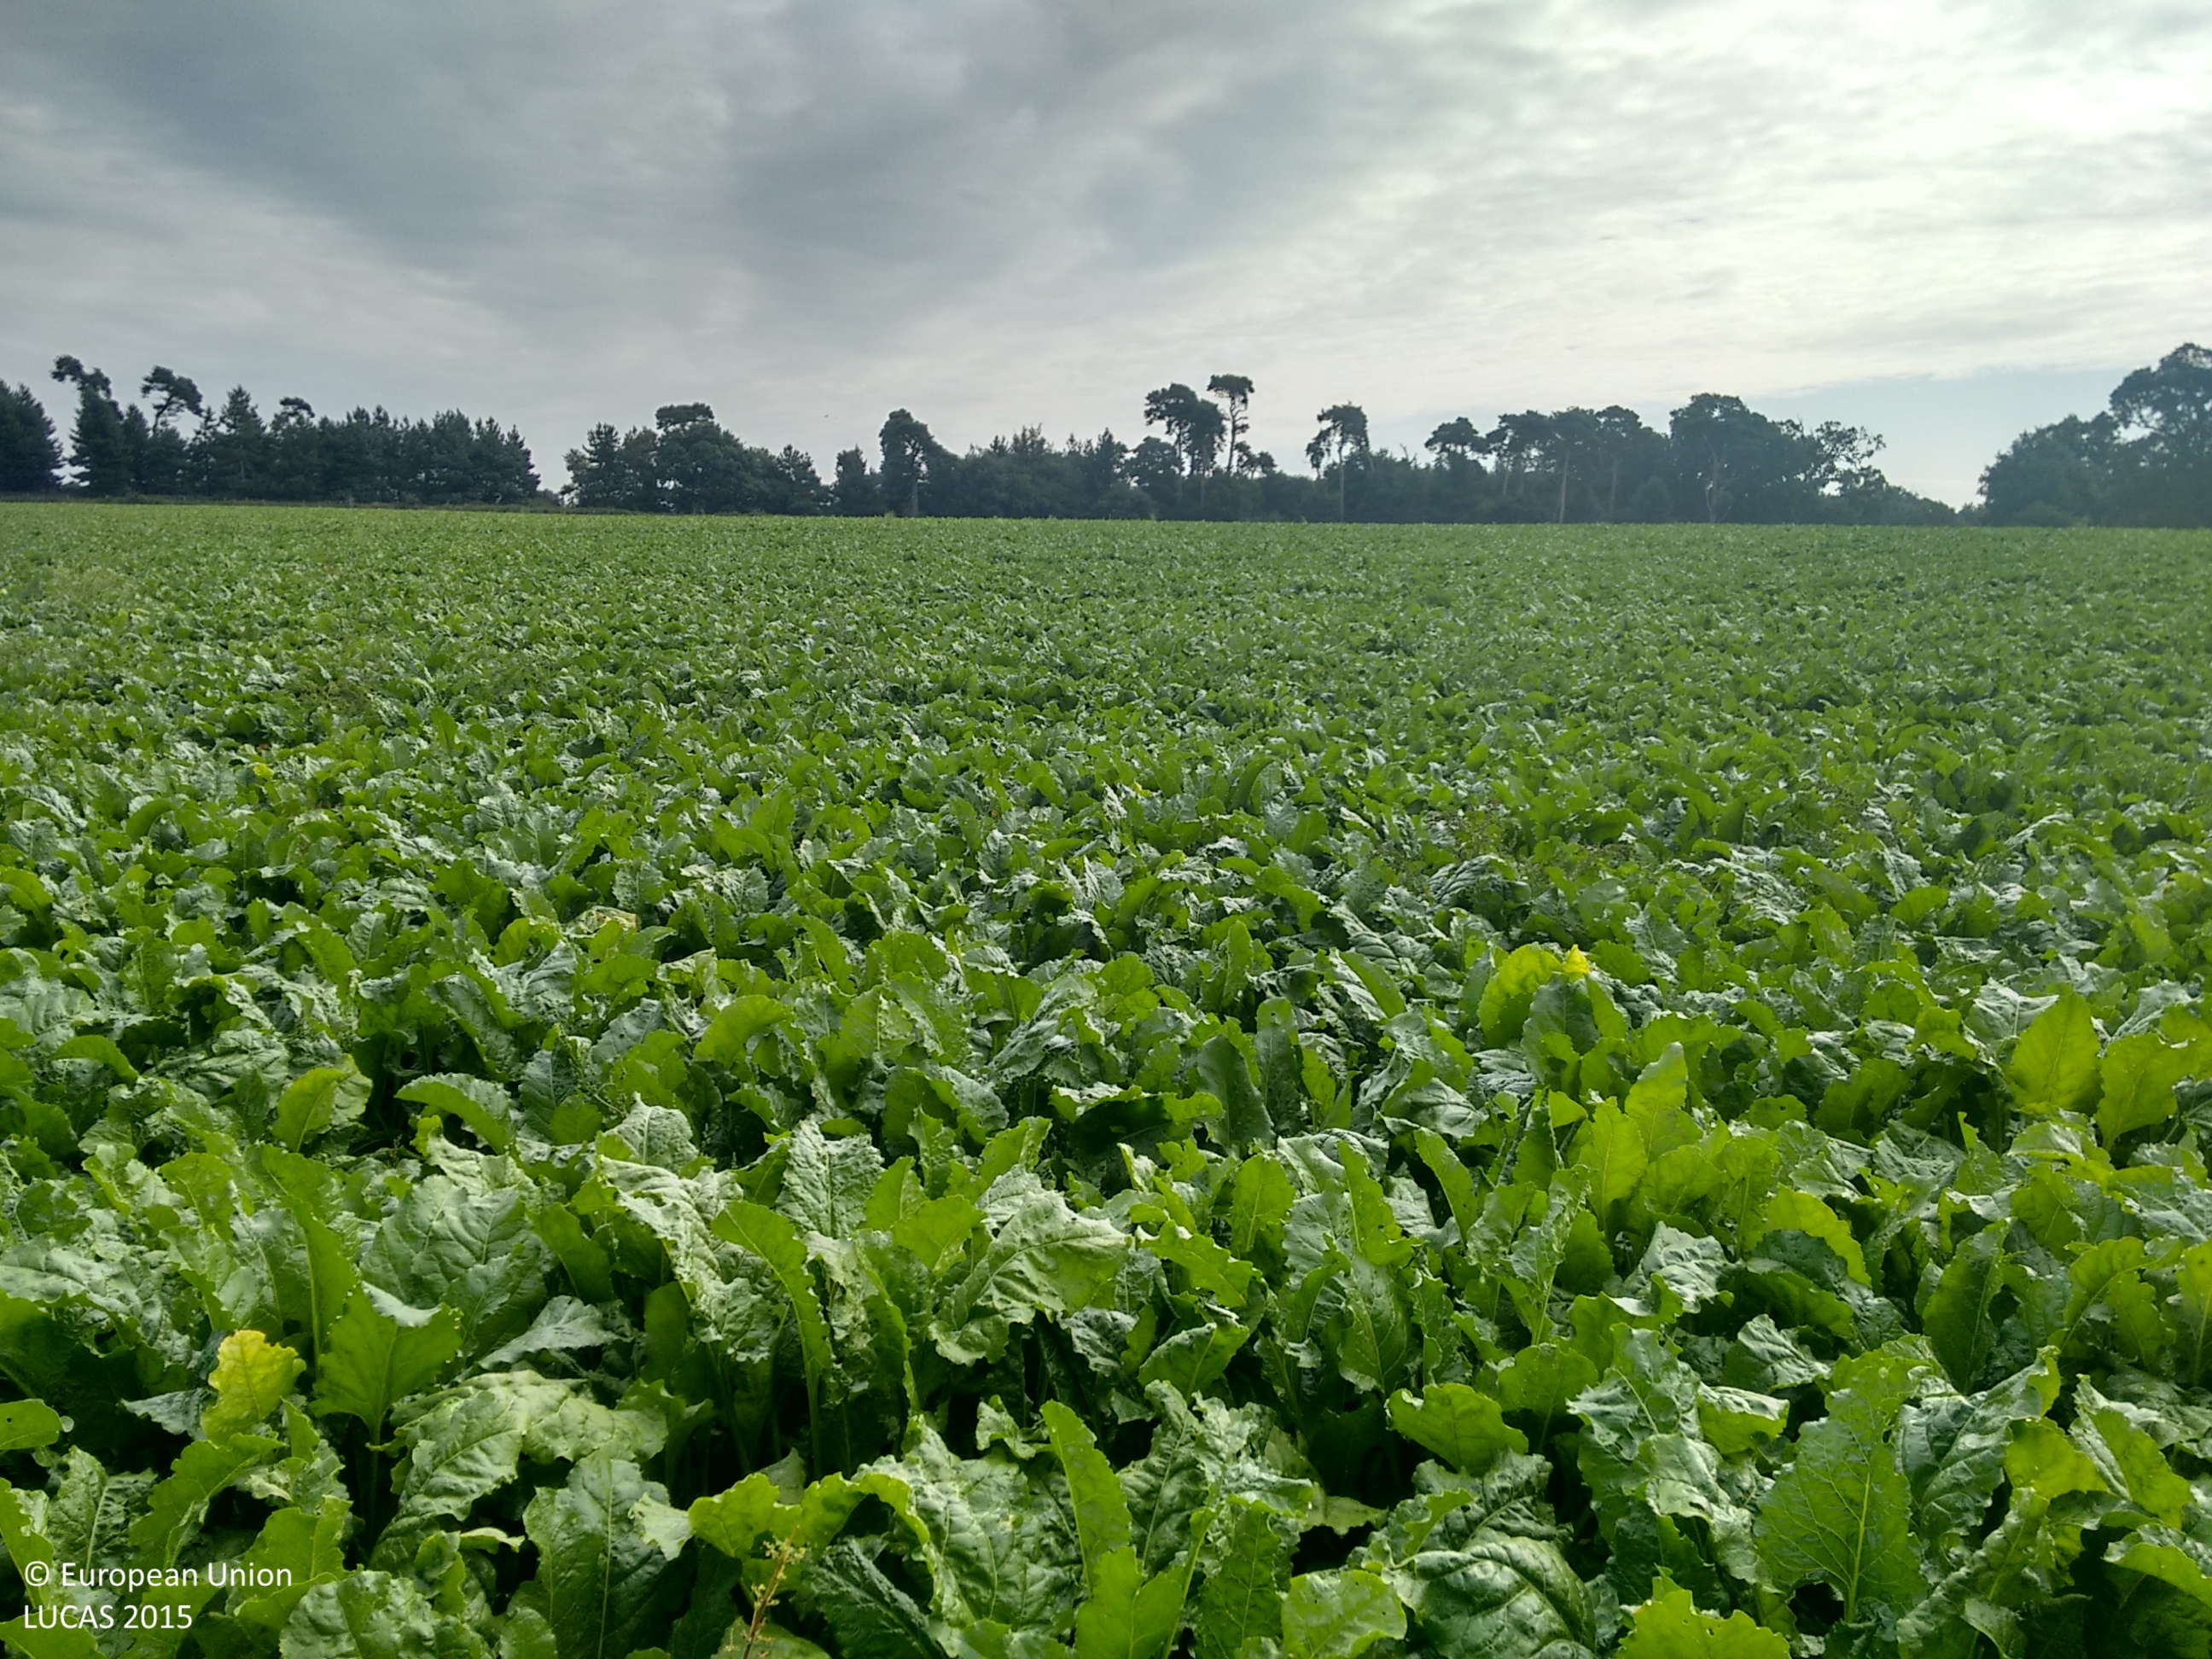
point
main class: Cropland
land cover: Sugar beet
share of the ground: > 75 %
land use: Agriculture (excluding fallow land and kitchen gardens)
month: August
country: GB
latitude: 52.0641
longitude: 1.3883
